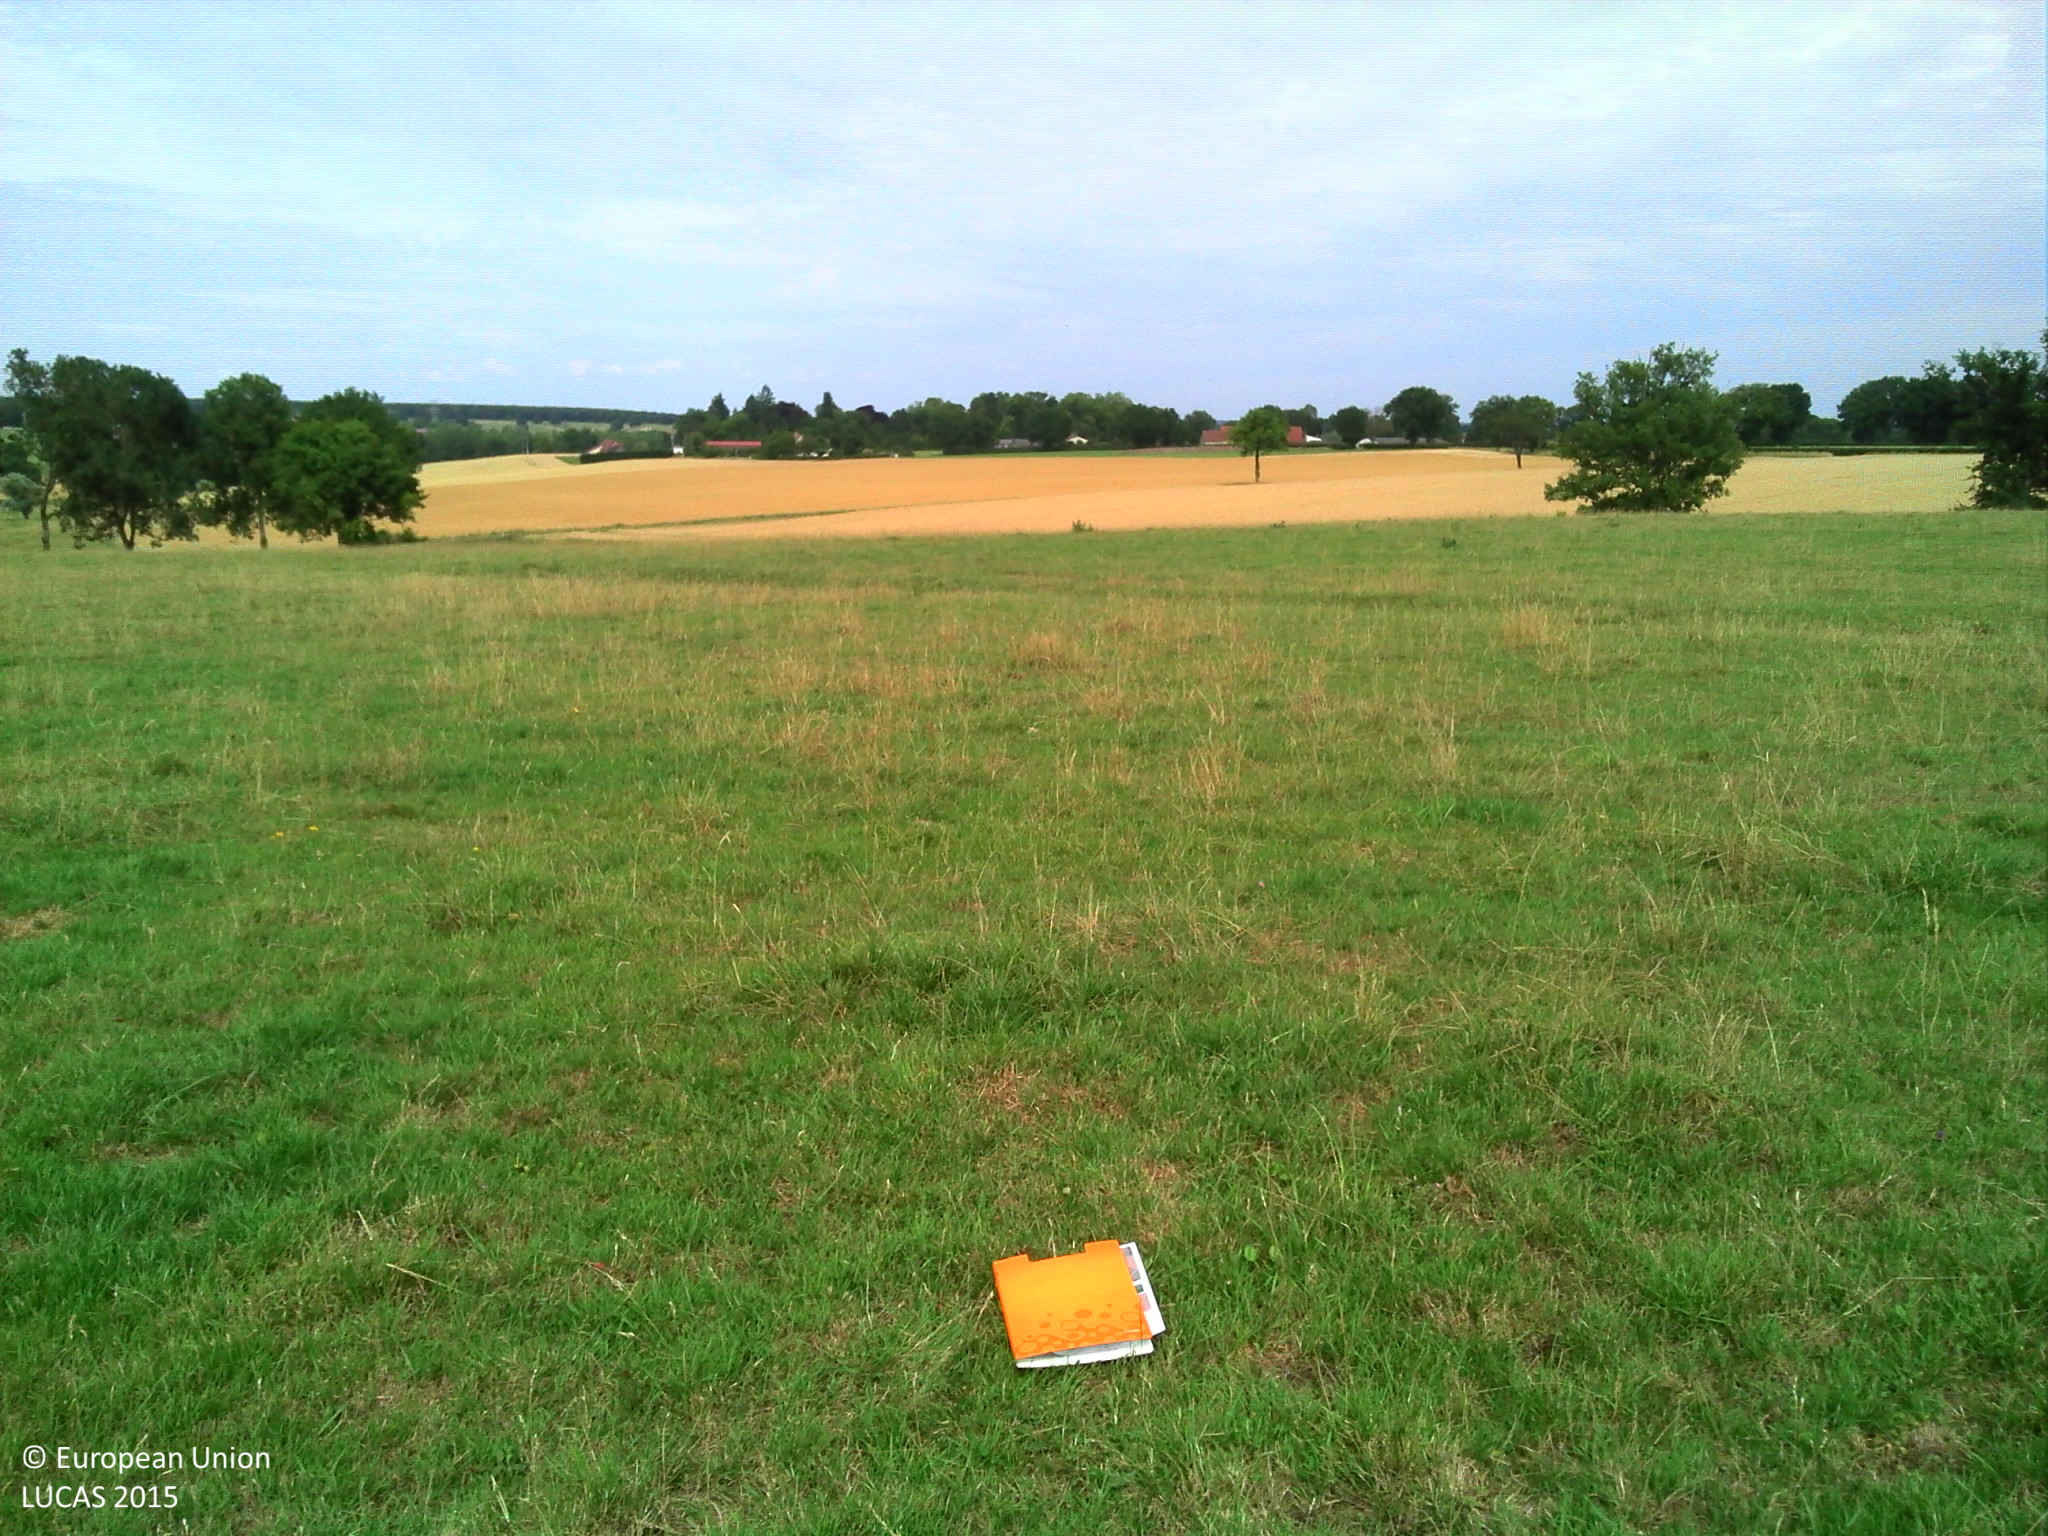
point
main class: Grassland
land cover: Grassland without tree/shrub cover
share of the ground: > 75 %
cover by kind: herbaceous plants 100 %
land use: Agriculture (excluding fallow land and kitchen gardens)
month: June
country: FR
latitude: 46.4805
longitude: 3.2378
